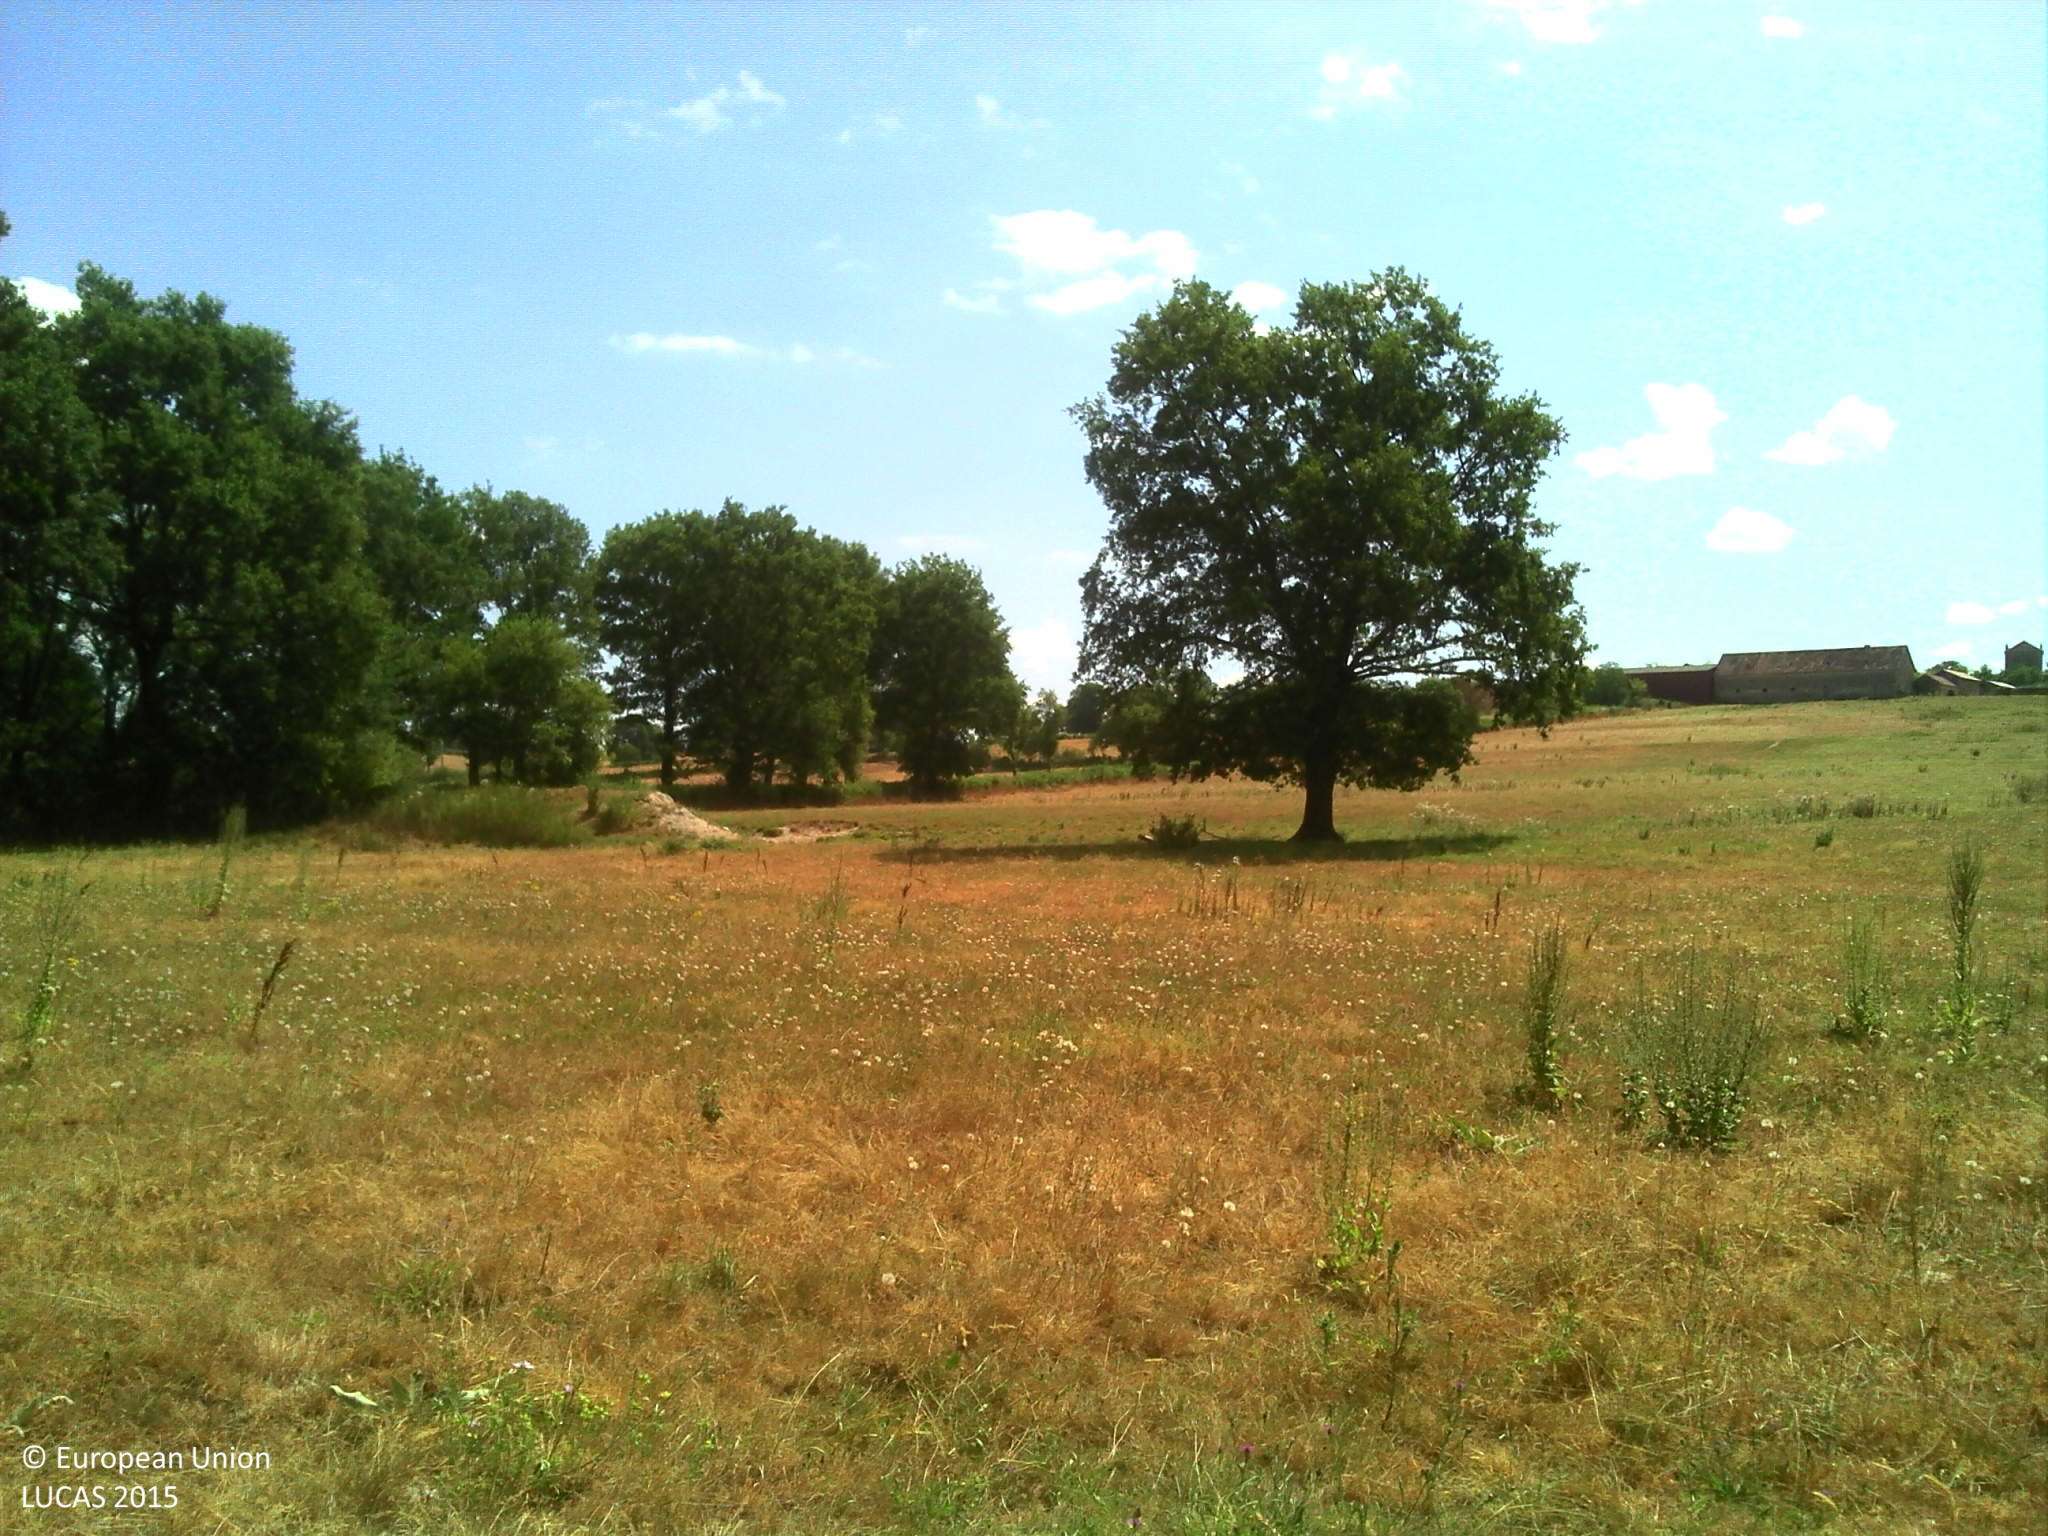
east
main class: Grassland
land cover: Grassland without tree/shrub cover
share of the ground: > 75 %
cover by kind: herbaceous plants 100 %
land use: Agriculture (excluding fallow land and kitchen gardens)
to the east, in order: Grassland without tree/shrub cover; Fences; Managed hedges; Tracks; Broadleaved woodland; Fences; Grassland without tree/shrub cover
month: July
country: FR
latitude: 46.4661
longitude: 2.7429
